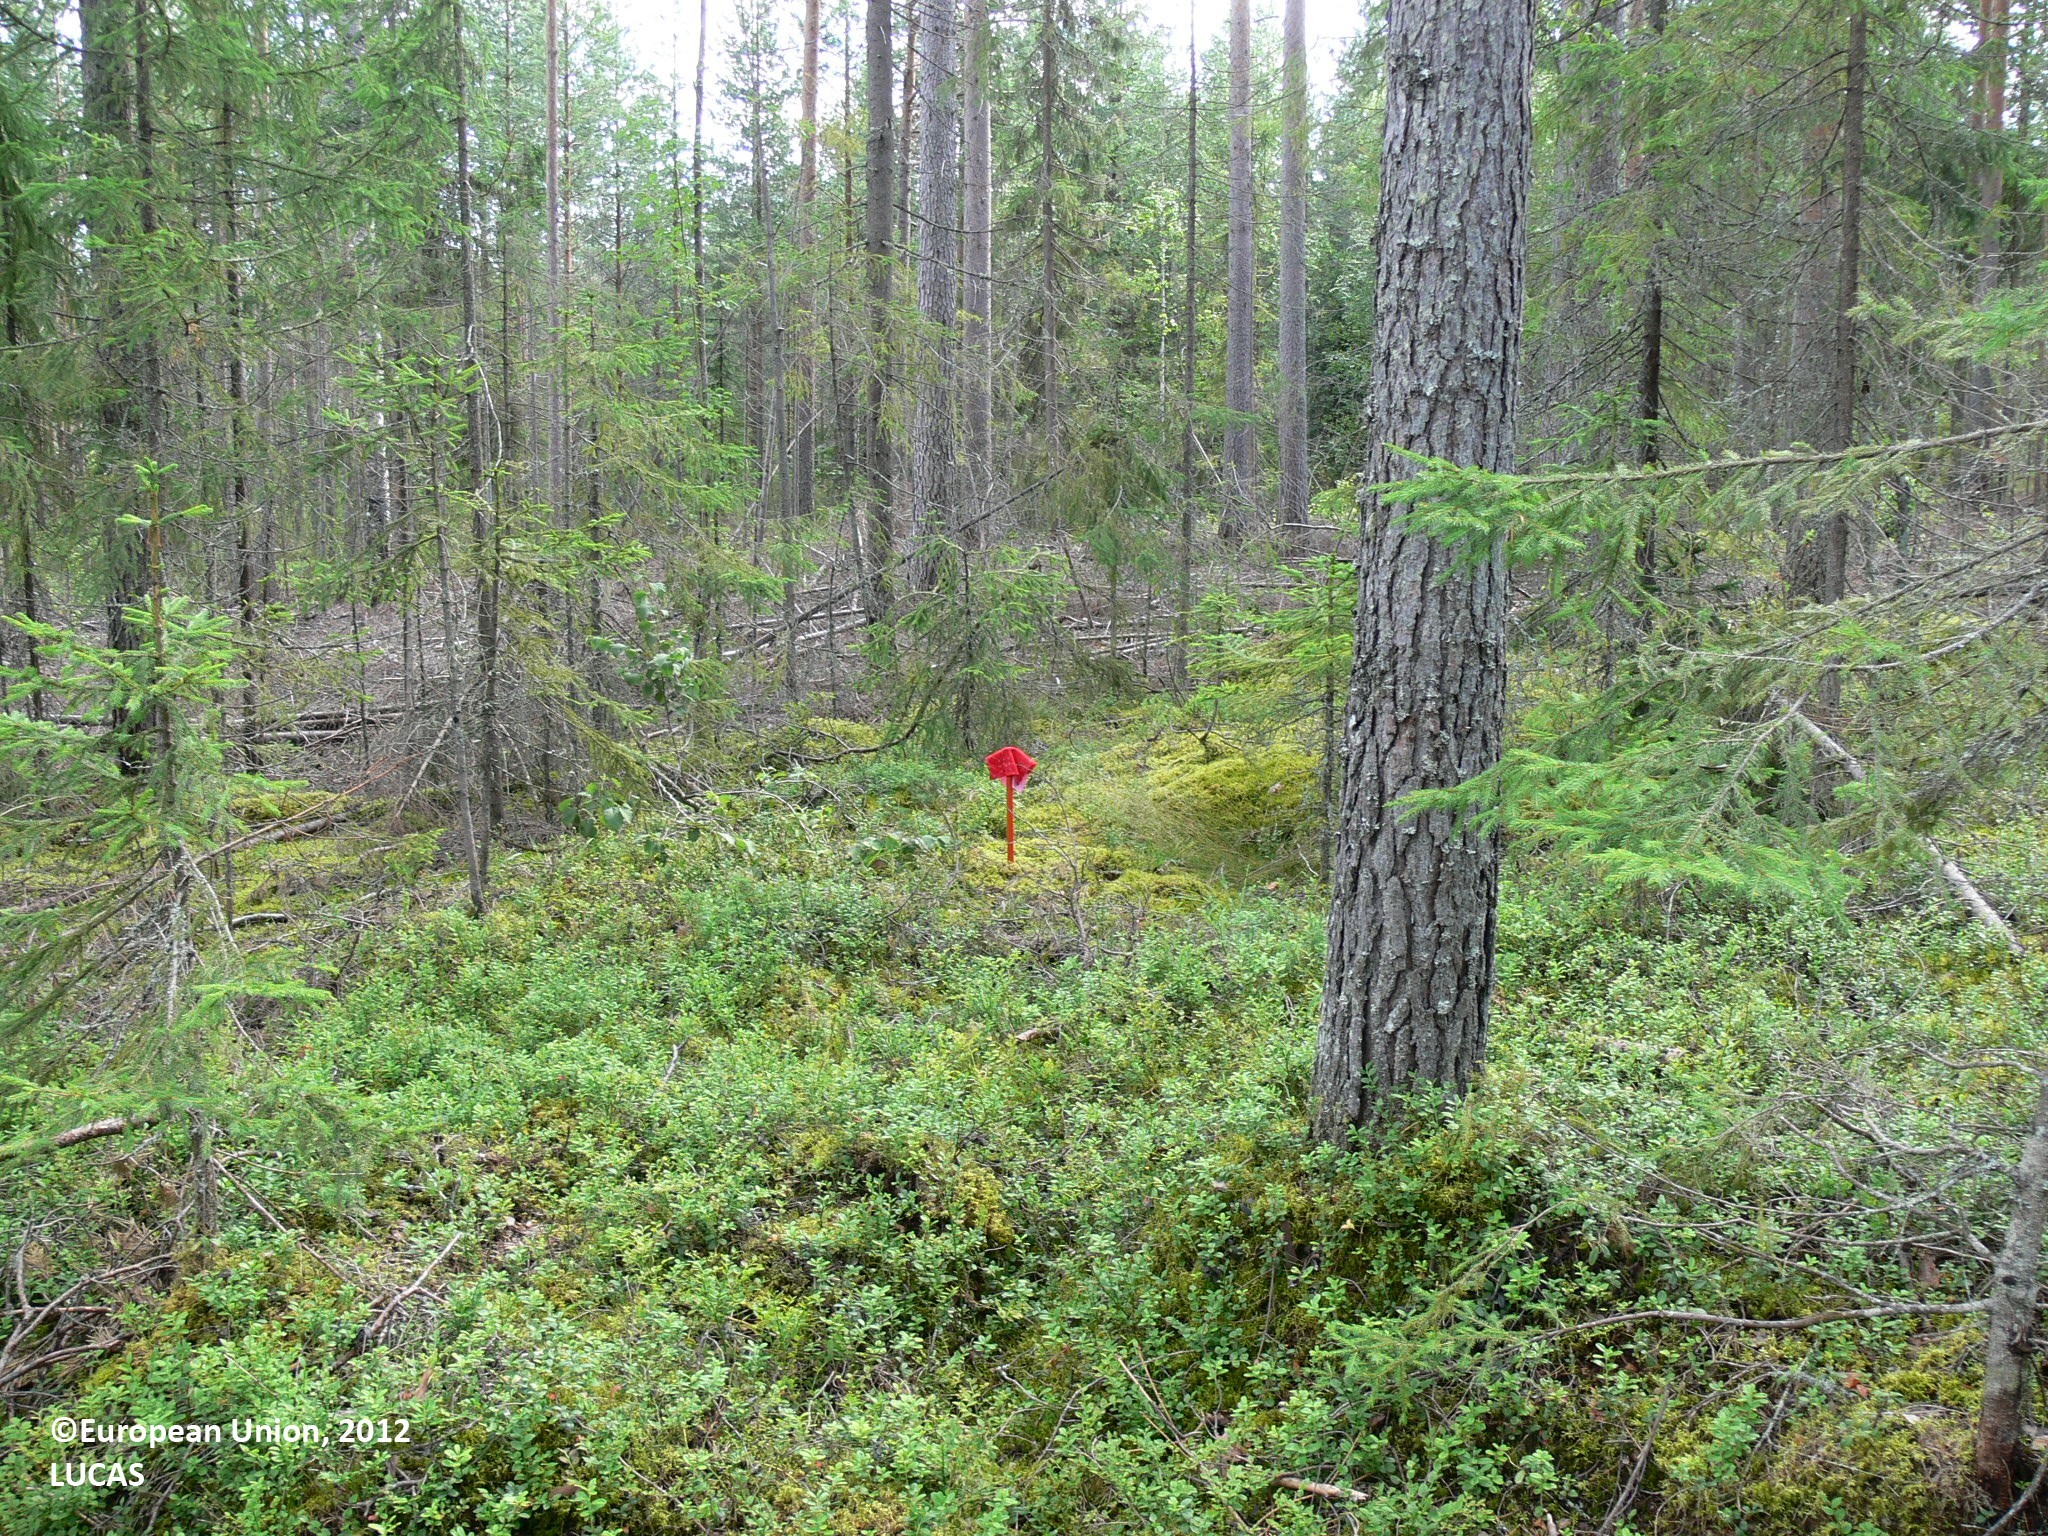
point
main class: Woodland
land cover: Pine dominated coniferous woodland
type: boreal forest
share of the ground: 50 - 75 %
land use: Forestry
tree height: > 5 m
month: July
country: FI
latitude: 63.2004
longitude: 29.2461
